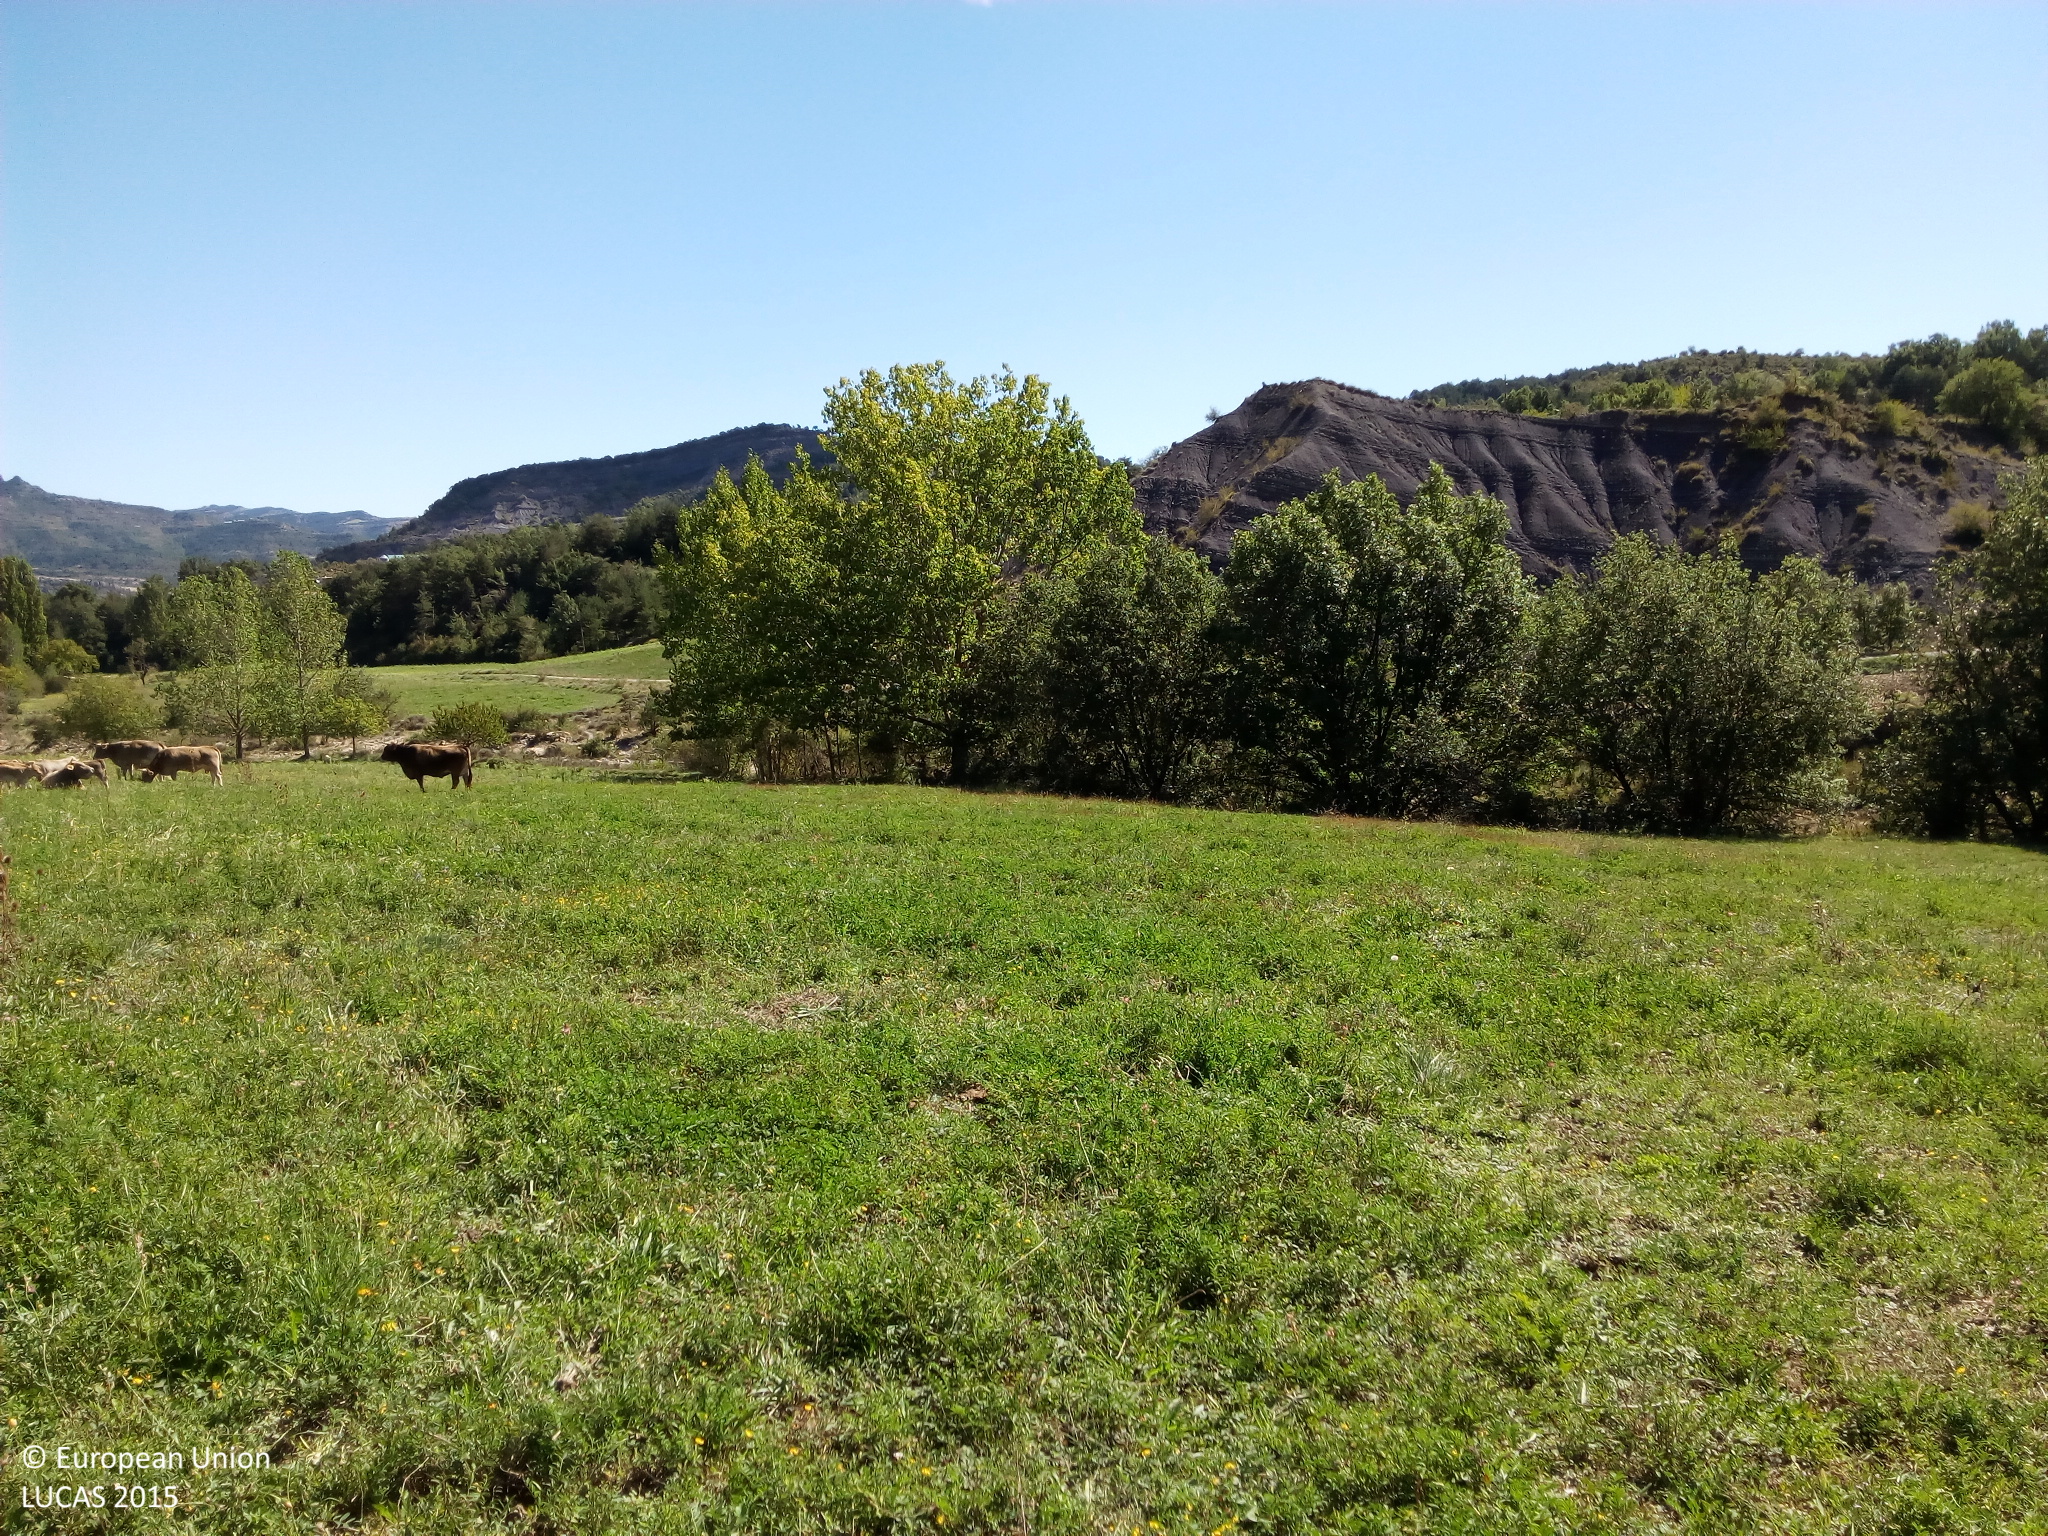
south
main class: Grassland
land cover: Grassland without tree/shrub cover
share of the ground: > 75 %
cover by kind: herbaceous plants 100 %
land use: Agriculture (excluding fallow land and kitchen gardens)
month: September
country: ES
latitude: 42.3162
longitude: 0.5058
